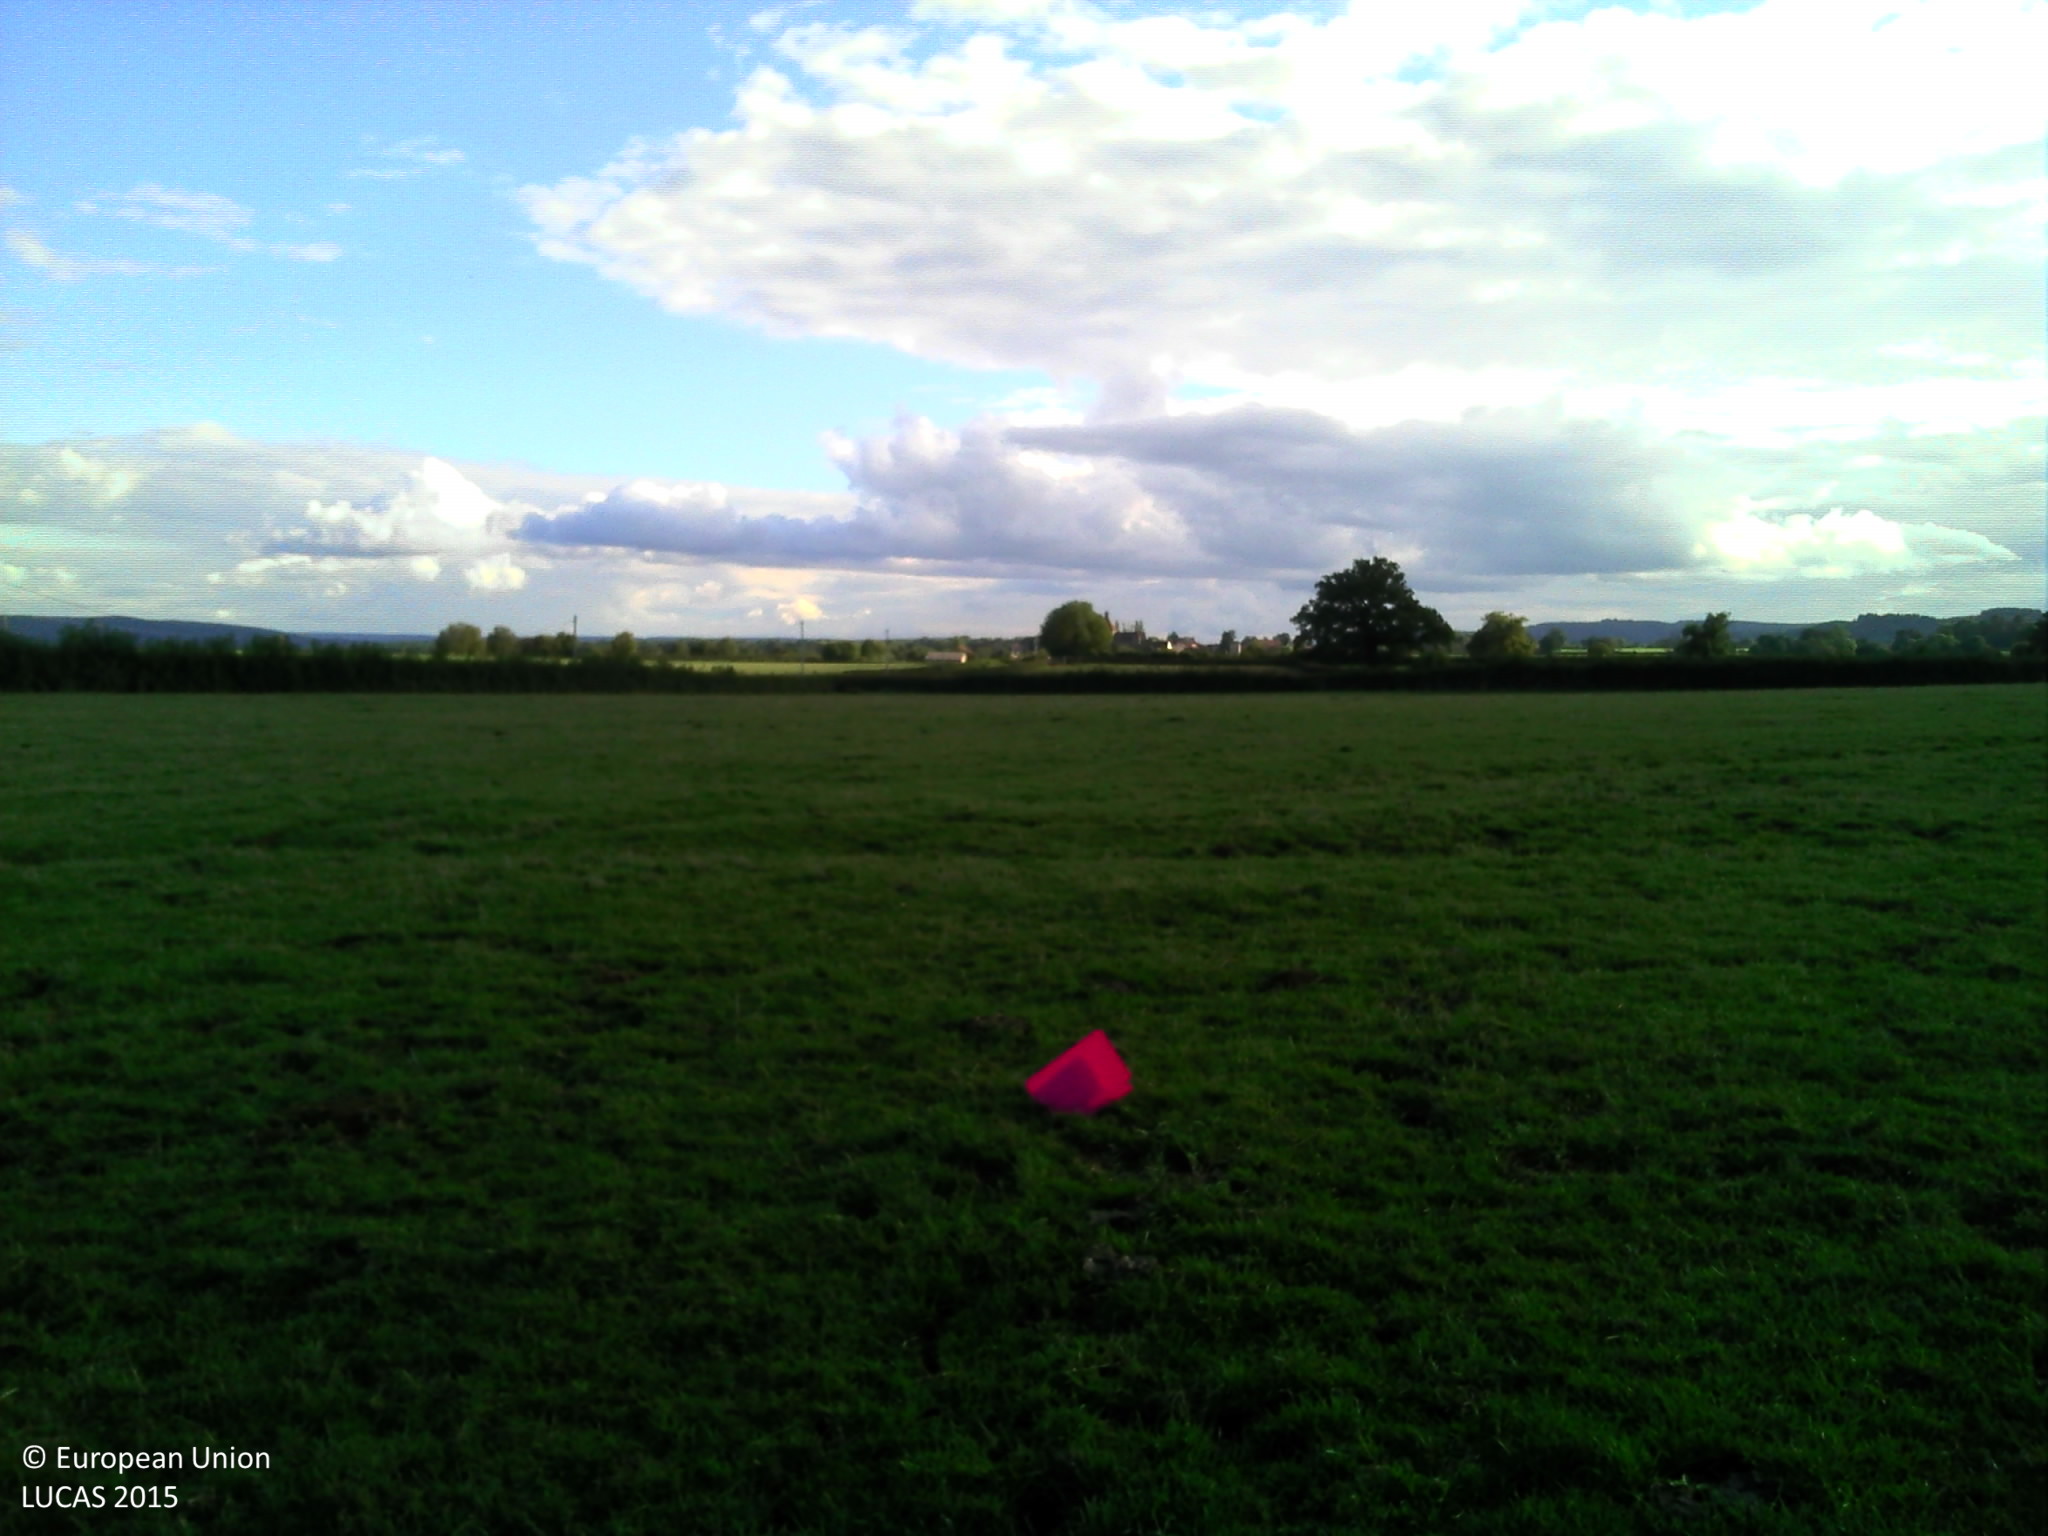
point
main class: Grassland
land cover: Grassland without tree/shrub cover
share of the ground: > 75 %
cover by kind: herbaceous plants 100 %
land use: Agriculture (excluding fallow land and kitchen gardens)
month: September
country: FR
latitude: 47.1401
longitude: 4.3429
